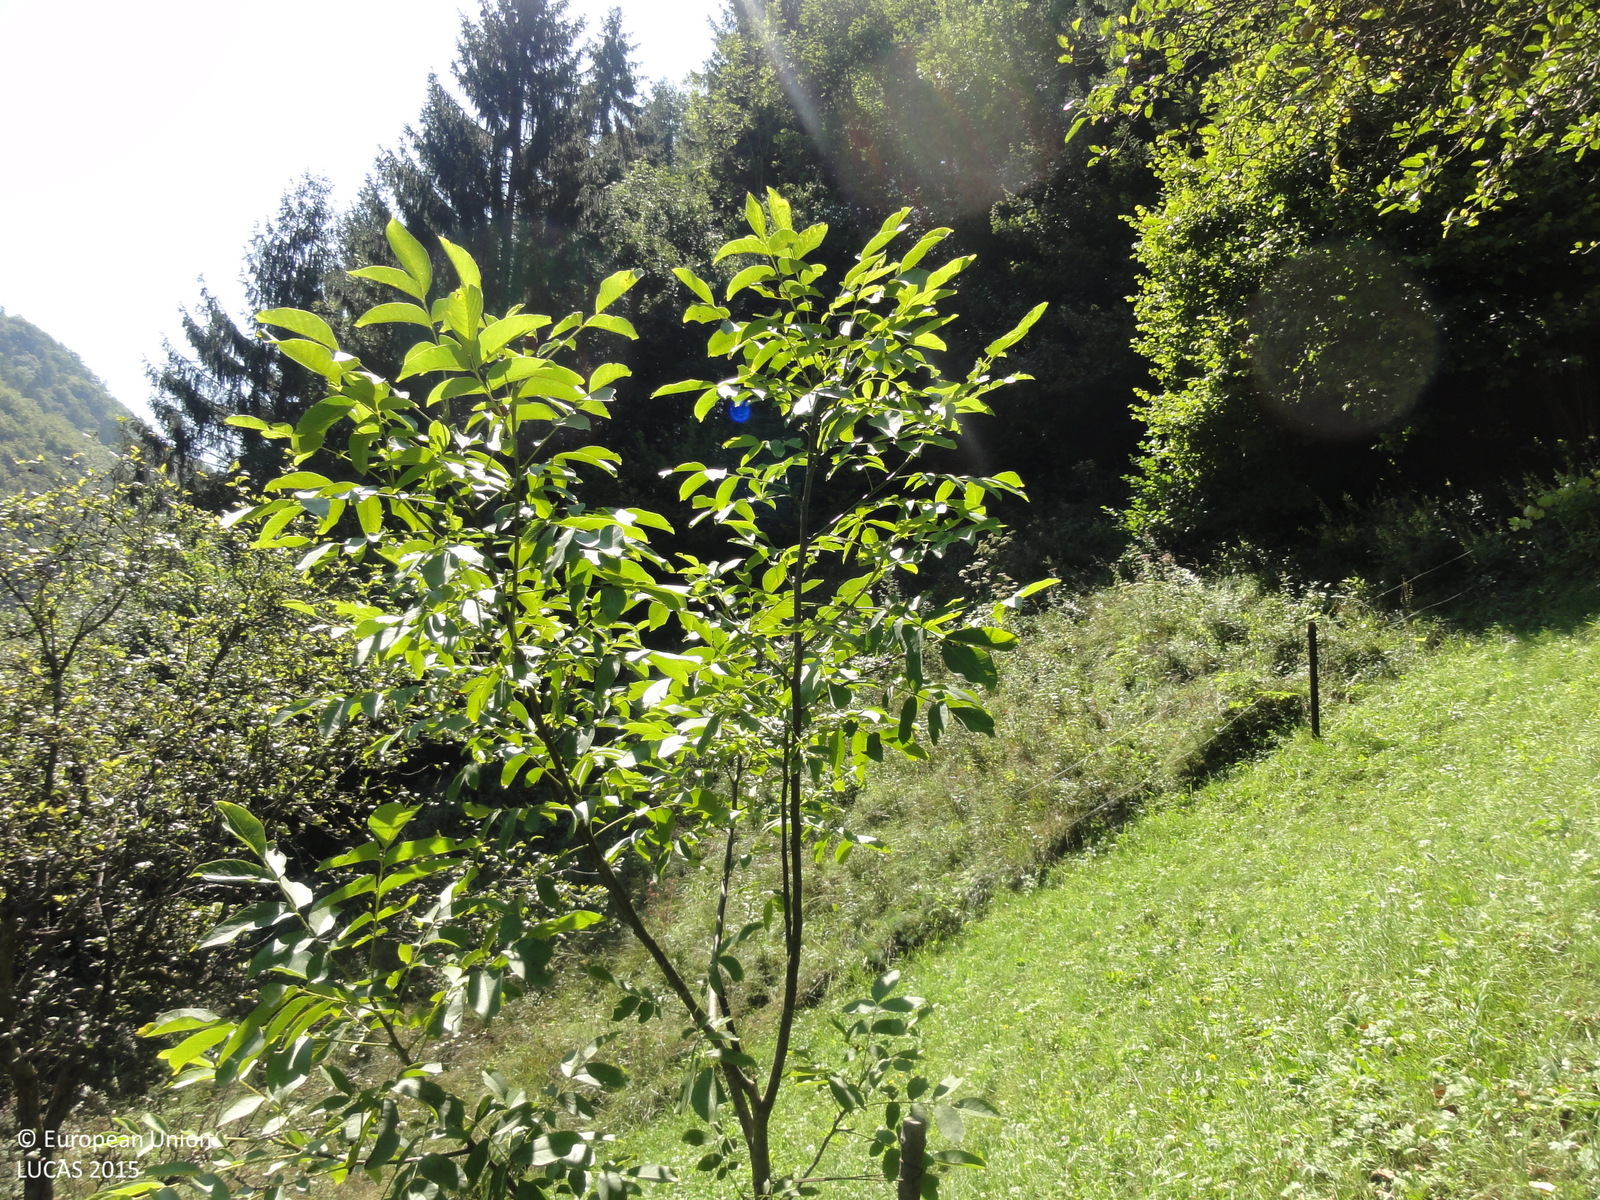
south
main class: Cropland
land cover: Apple fruit
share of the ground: 50 - 75 %
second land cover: Grassland without tree/shrub cover
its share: > 75 %
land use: Kitchen garden
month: August
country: SI
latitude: 46.1581
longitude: 15.0864
